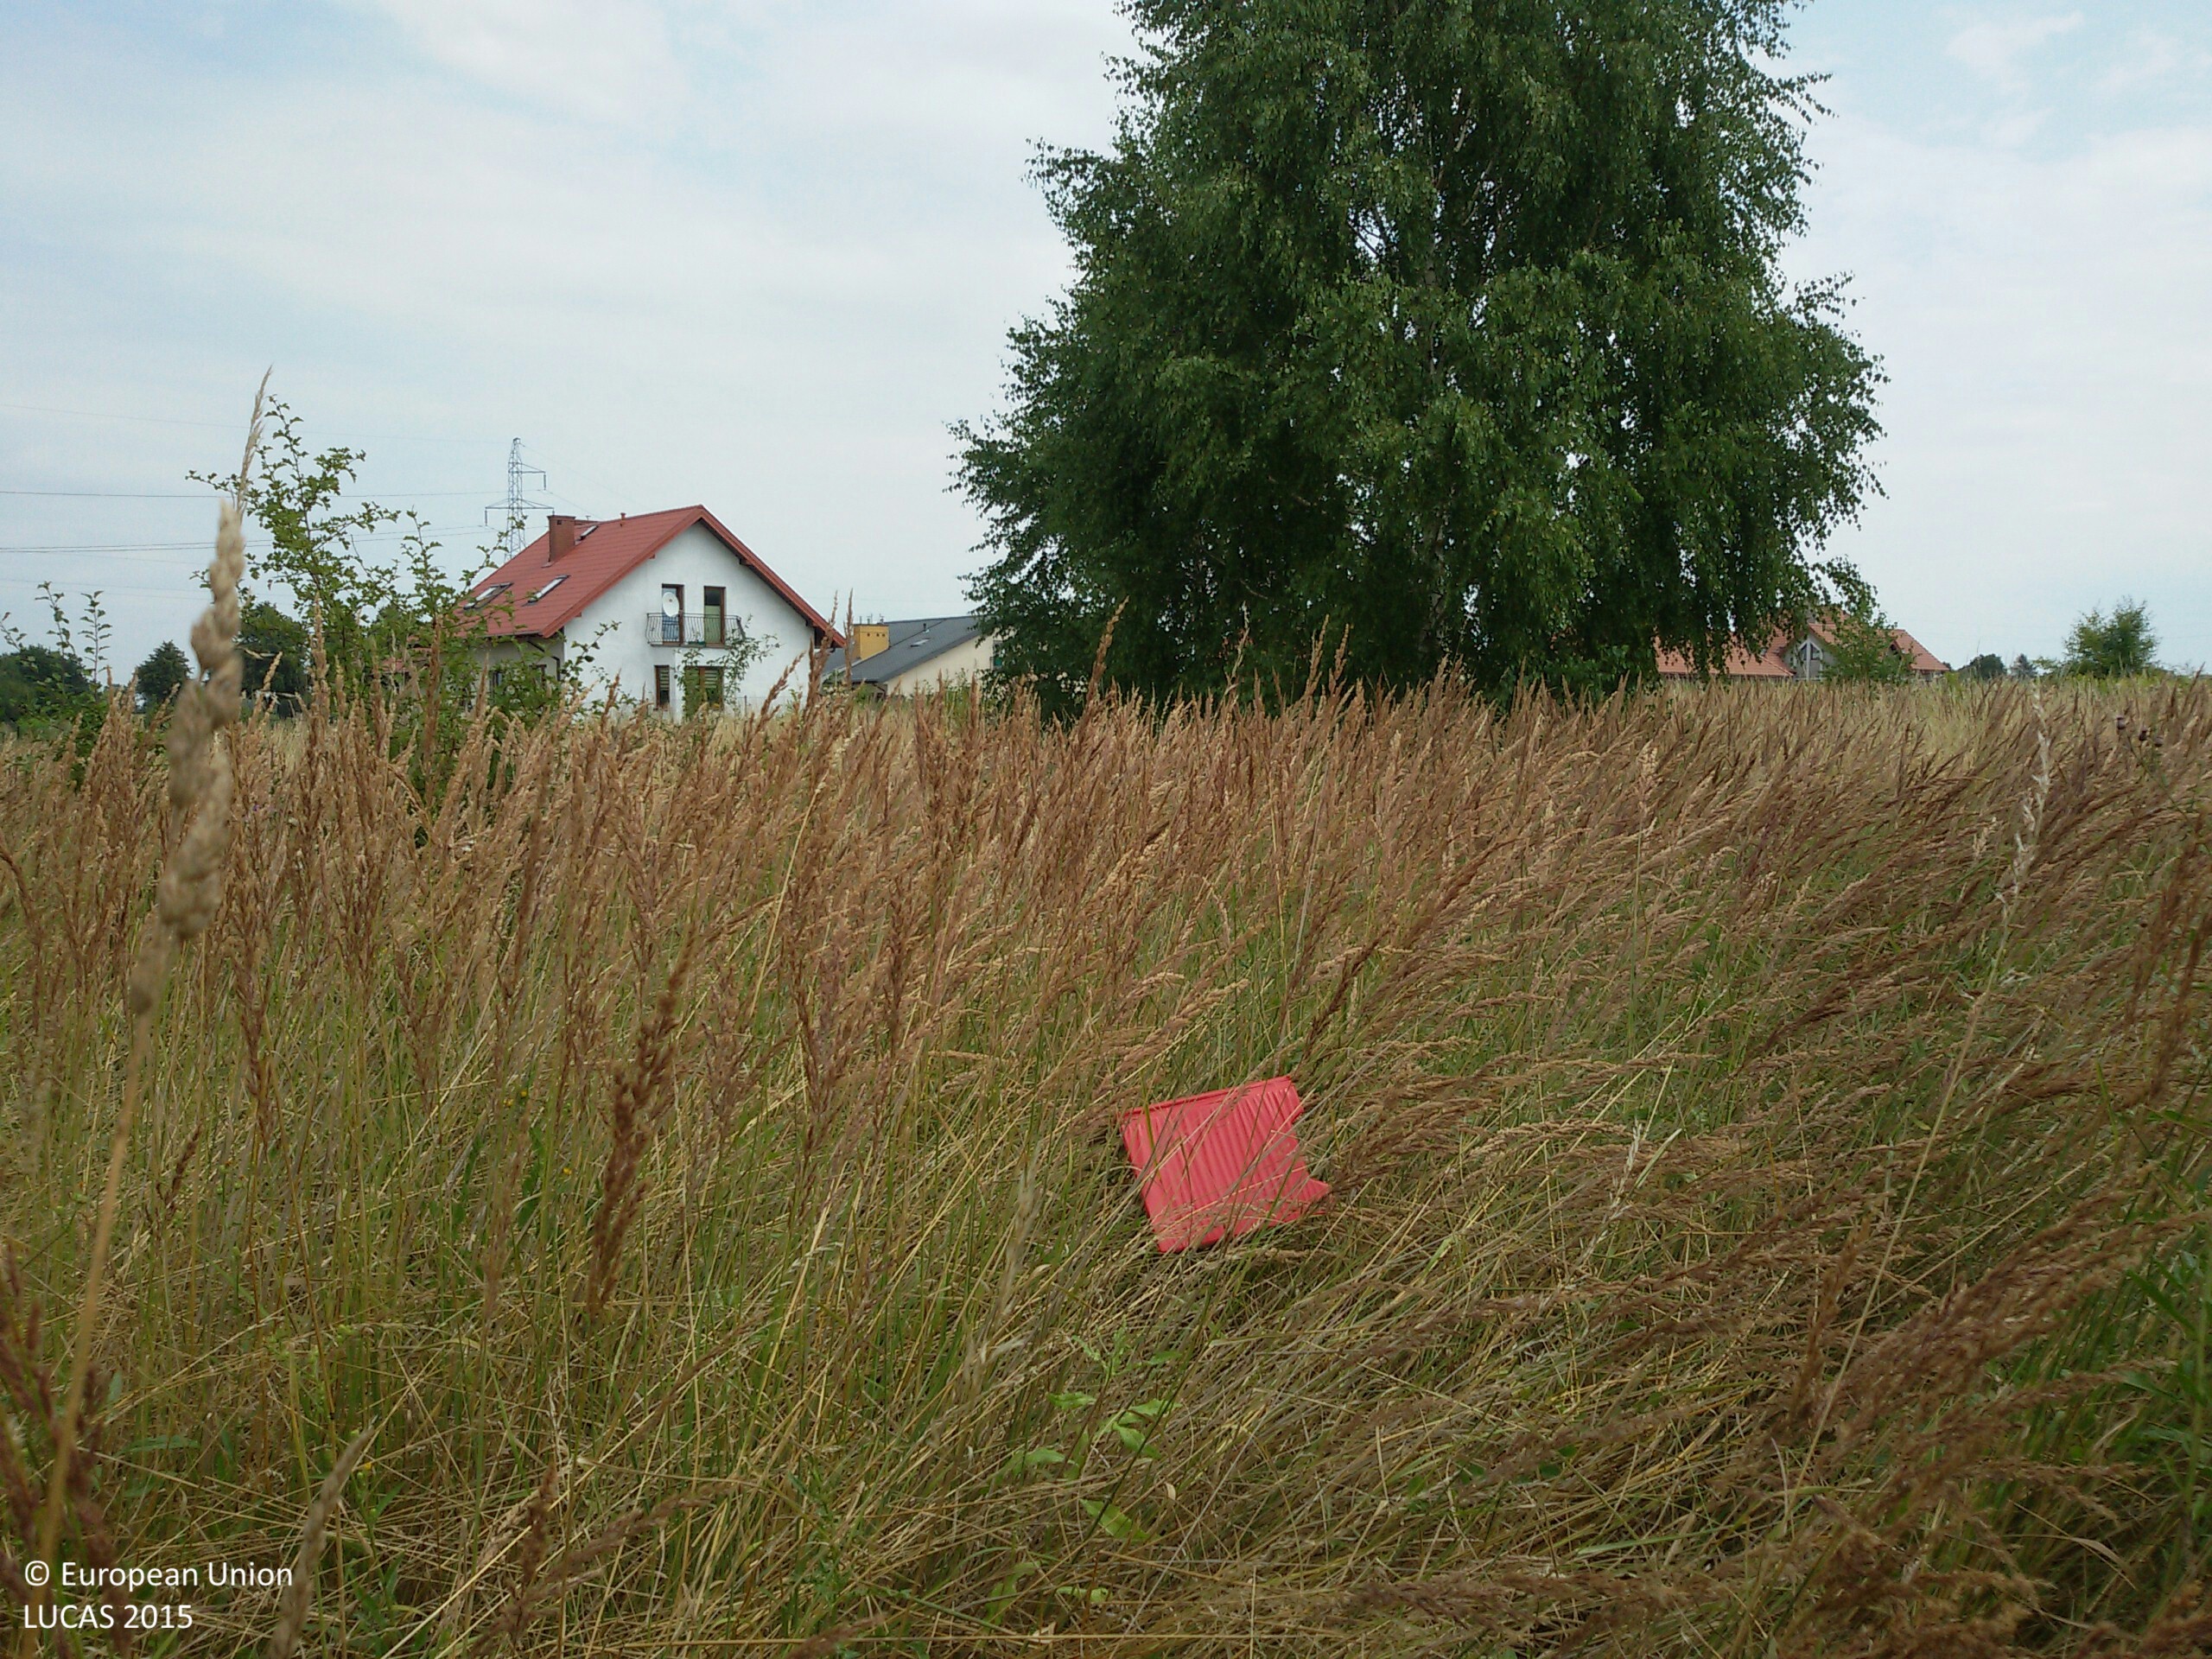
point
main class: Woodland
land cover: Broadleaved woodland
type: mesophytic deciduous forest
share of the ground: 10 - 25 %
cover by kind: herbaceous plants 85 %, broadleaved forest trees 15 %
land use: Abandoned areas
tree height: > 5 m
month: August
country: PL
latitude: 51.3231
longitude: 22.7414
